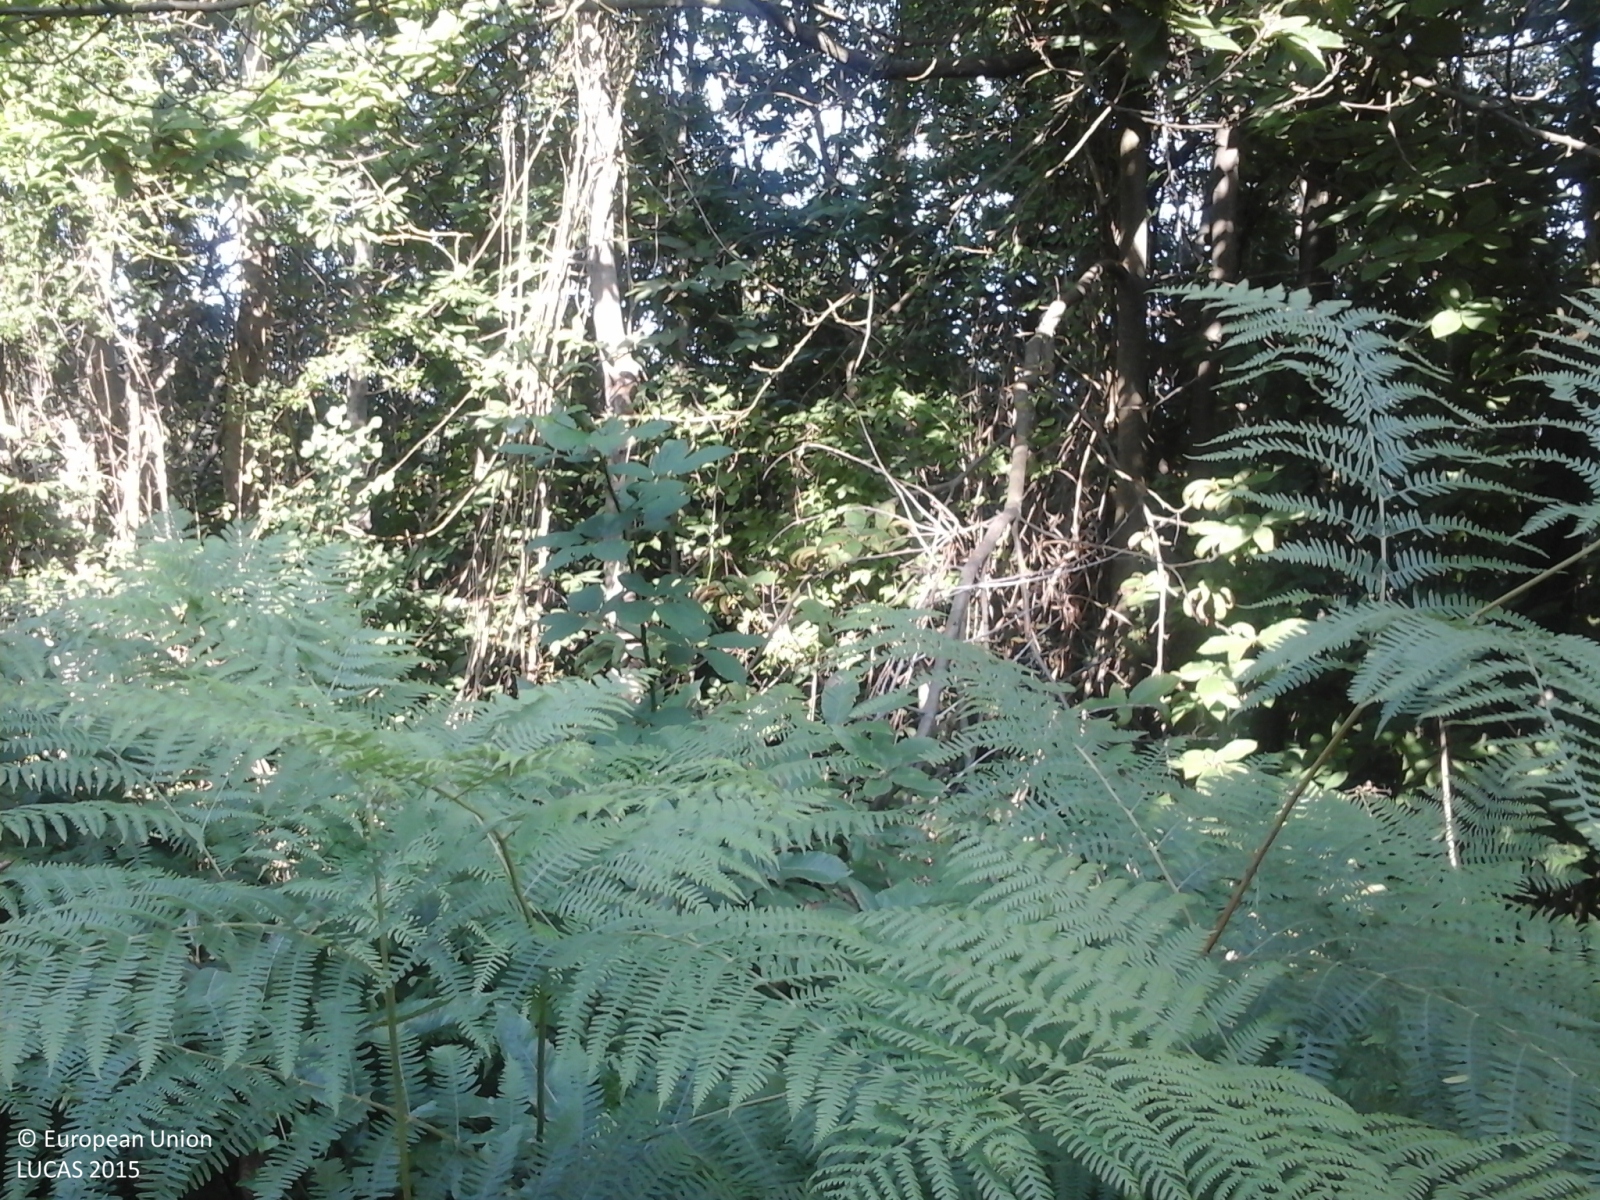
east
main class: Woodland
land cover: Broadleaved woodland
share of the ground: > 75 %
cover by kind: broadleaved forest trees 100 %
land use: Forestry
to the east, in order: Broadleaved woodland; Paved roads, cycling and walking lanes; Broadleaved woodland; Paved roads, cycling and walking lanes; Broadleaved woodland; Grassland without tree/shrub cover; Broadleaved woodland
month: July
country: IT
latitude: 44.3699
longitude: 8.1343
